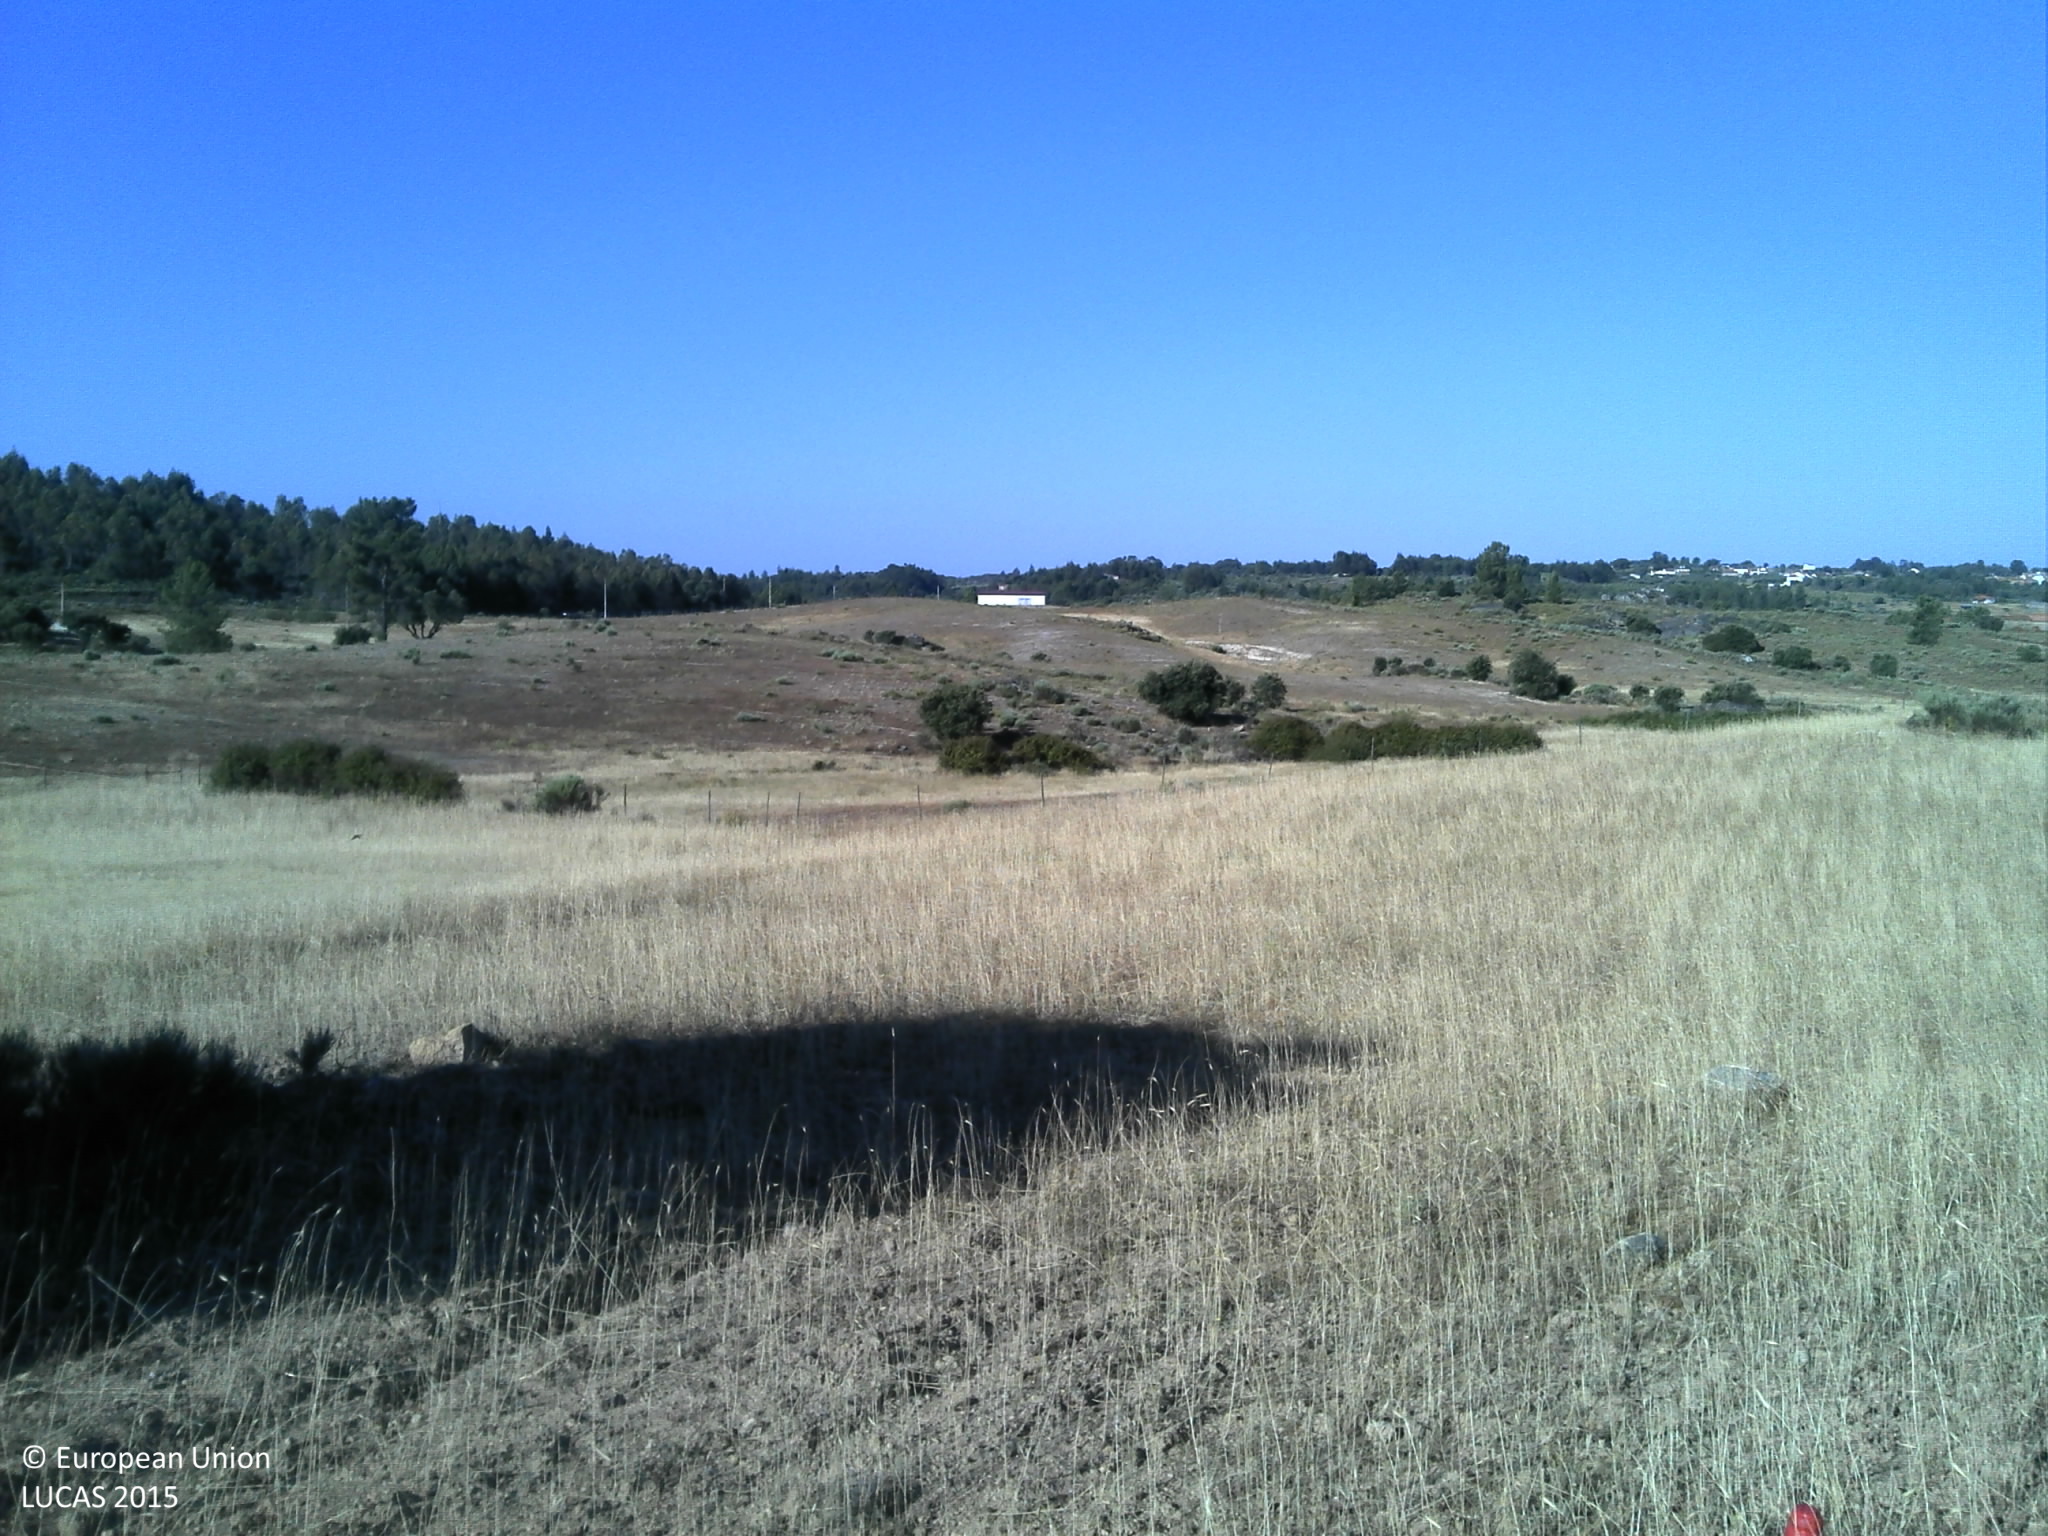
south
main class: Grassland
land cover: Grassland with sparse tree/shrub cover
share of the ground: 25 - 50 %
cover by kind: herbaceous plants 45 %, unconsolidated bare surface 40 %, shrubs 10 %, broadleaved forest trees 5 %
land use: Agriculture (excluding fallow land and kitchen gardens)
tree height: < 5 m
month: June
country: PT
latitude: 40.0821
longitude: -7.3030
